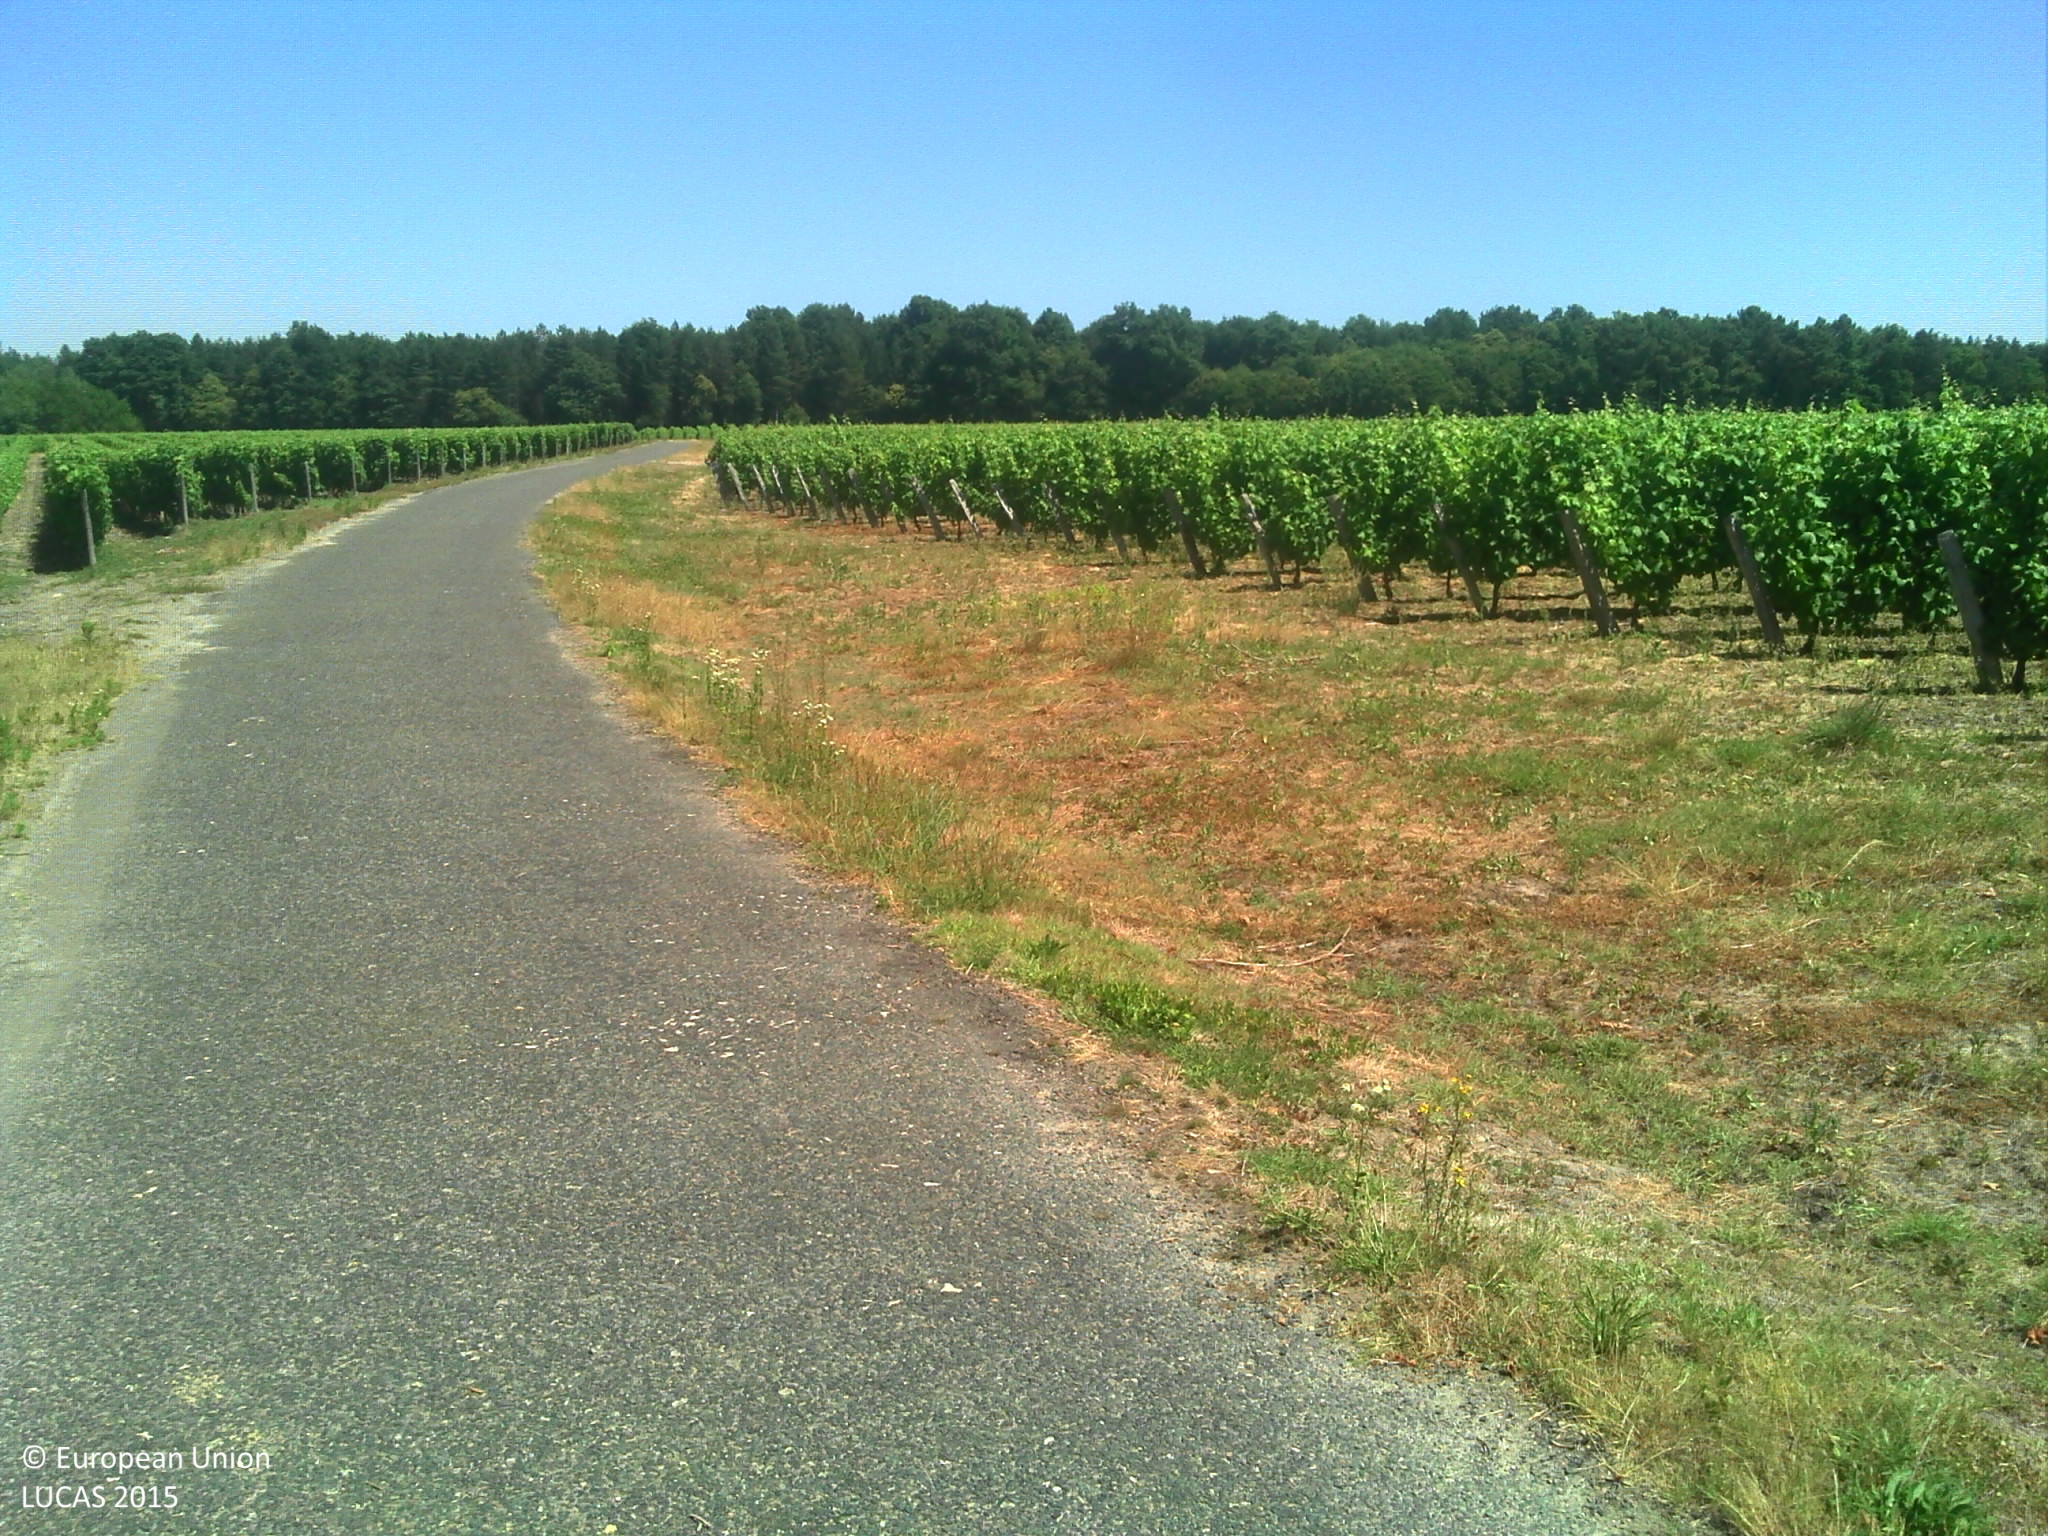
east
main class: Grassland
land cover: Grassland without tree/shrub cover
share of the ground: > 75 %
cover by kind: herbaceous plants 80 %, unconsolidated bare surface 20 %
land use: Agriculture (excluding fallow land and kitchen gardens)
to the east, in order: Paved roads, cycling and walking lanes; Grass margins; Vineyards; Grassland without tree/shrub cover; Vineyards
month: June
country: FR
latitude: 47.3059
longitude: 1.3754
